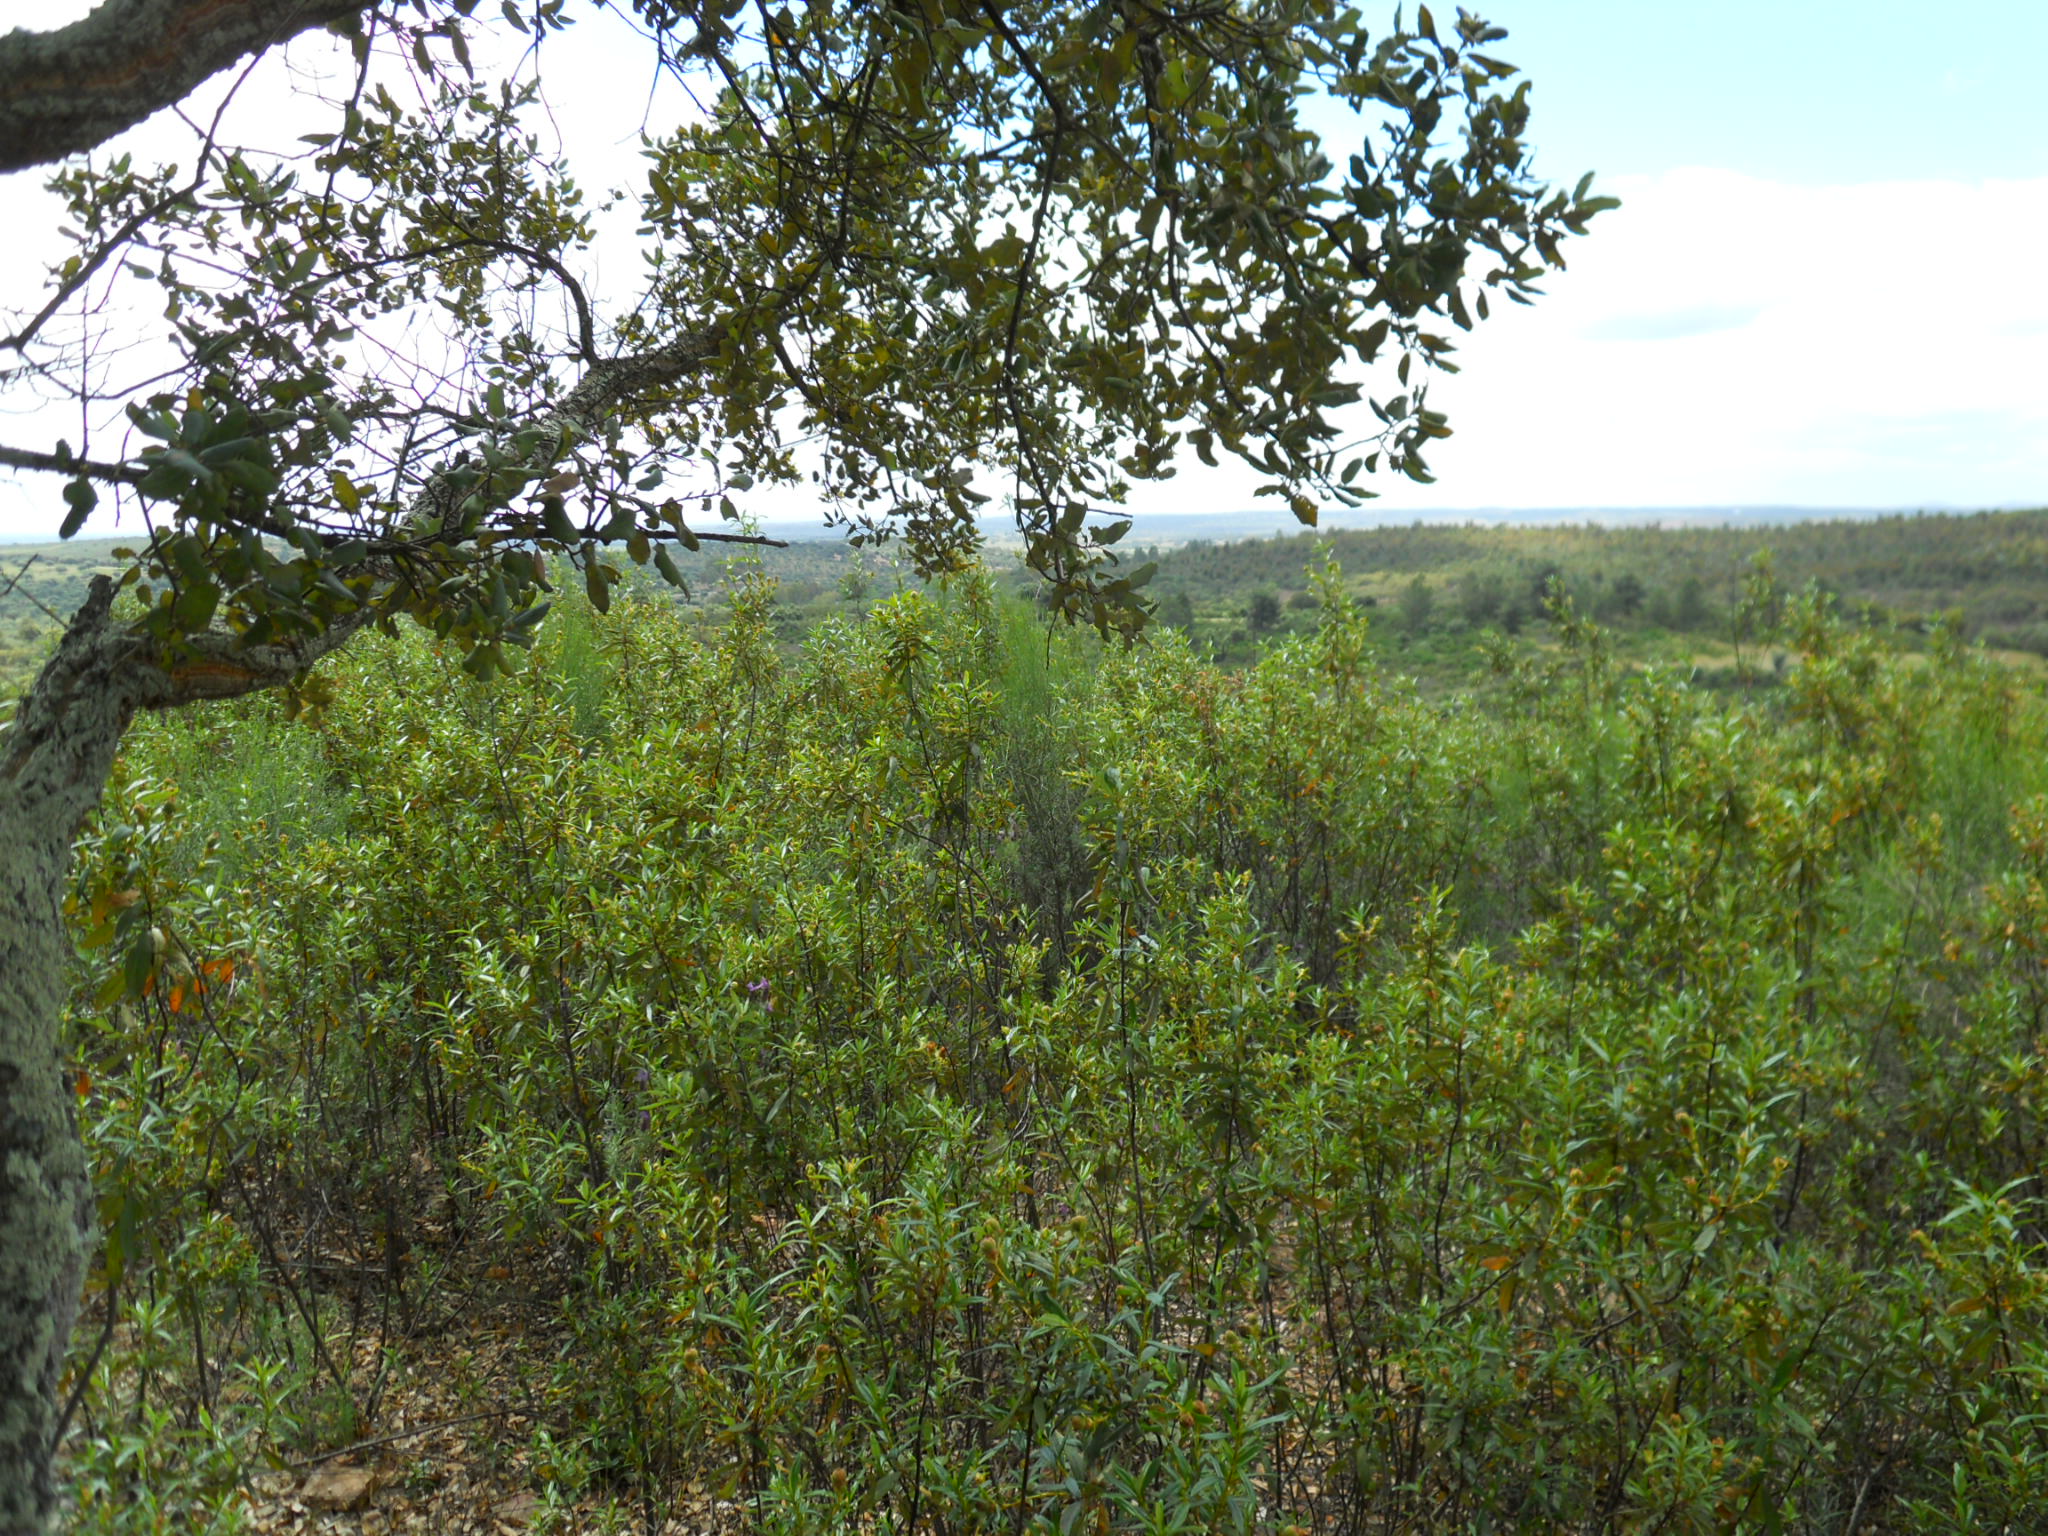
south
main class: Woodland
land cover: Broadleaved woodland
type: broadleaved evergreen forest
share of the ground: > 75 %
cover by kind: broadleaved forest trees 90 %, unconsolidated bare surface 10 %
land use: Forestry
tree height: > 5 m
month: May
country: ES
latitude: 39.1631
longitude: -7.0786
